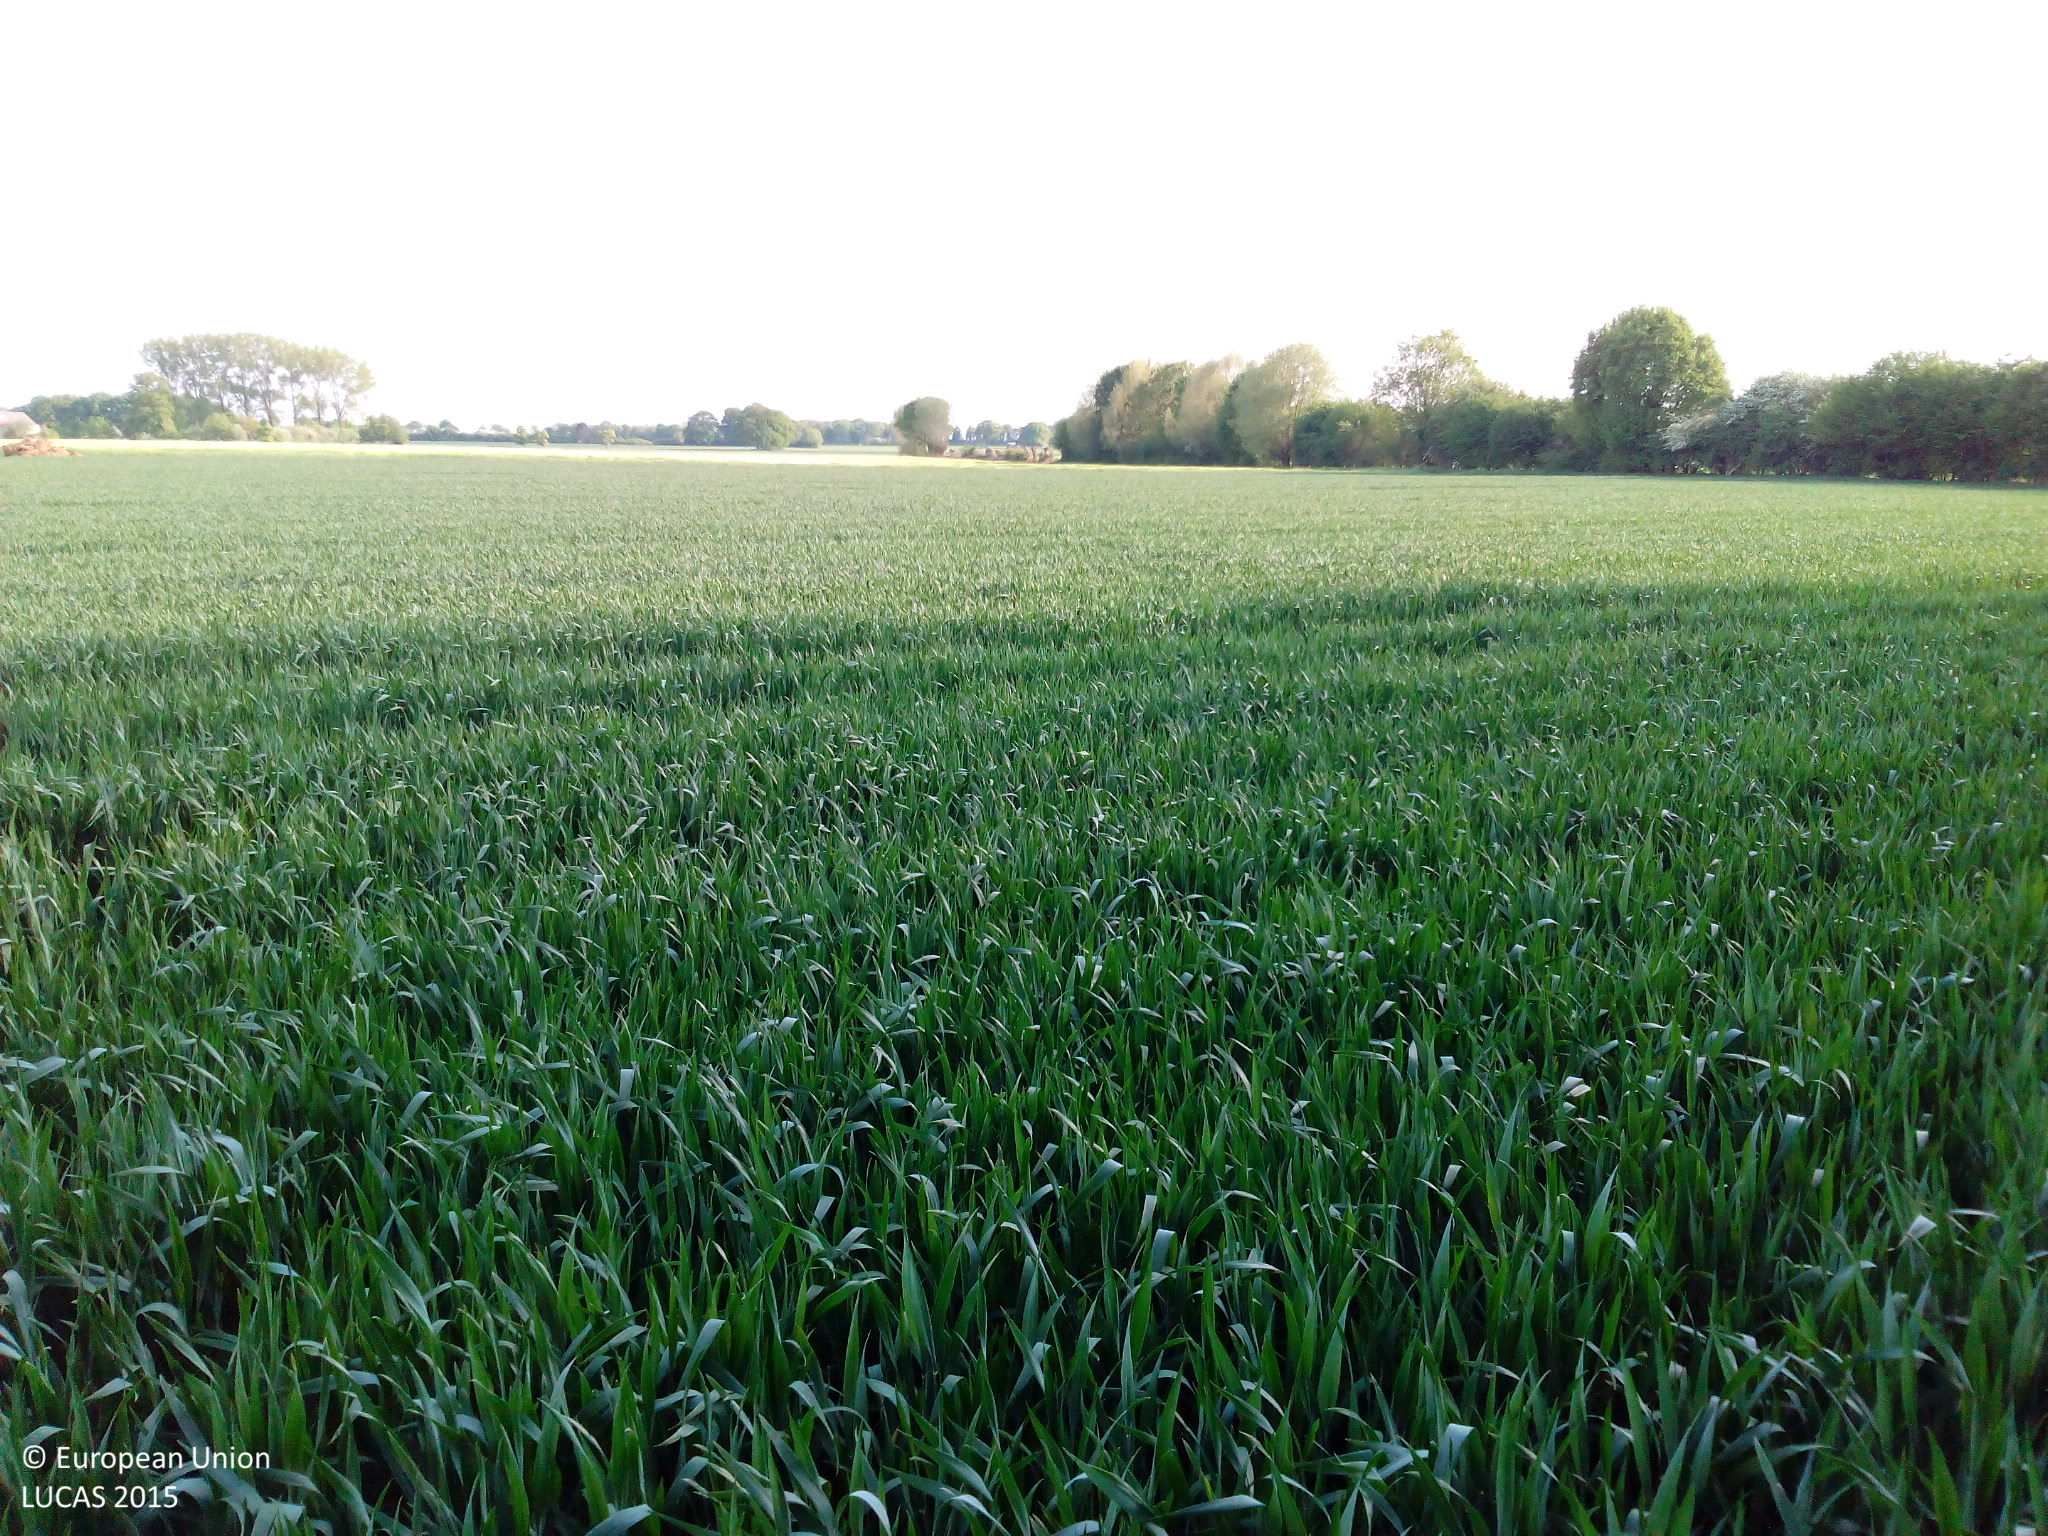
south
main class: Cropland
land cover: Common wheat
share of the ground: > 75 %
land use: Agriculture (excluding fallow land and kitchen gardens)
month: May
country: DE
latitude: 51.8564
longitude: 7.9532
